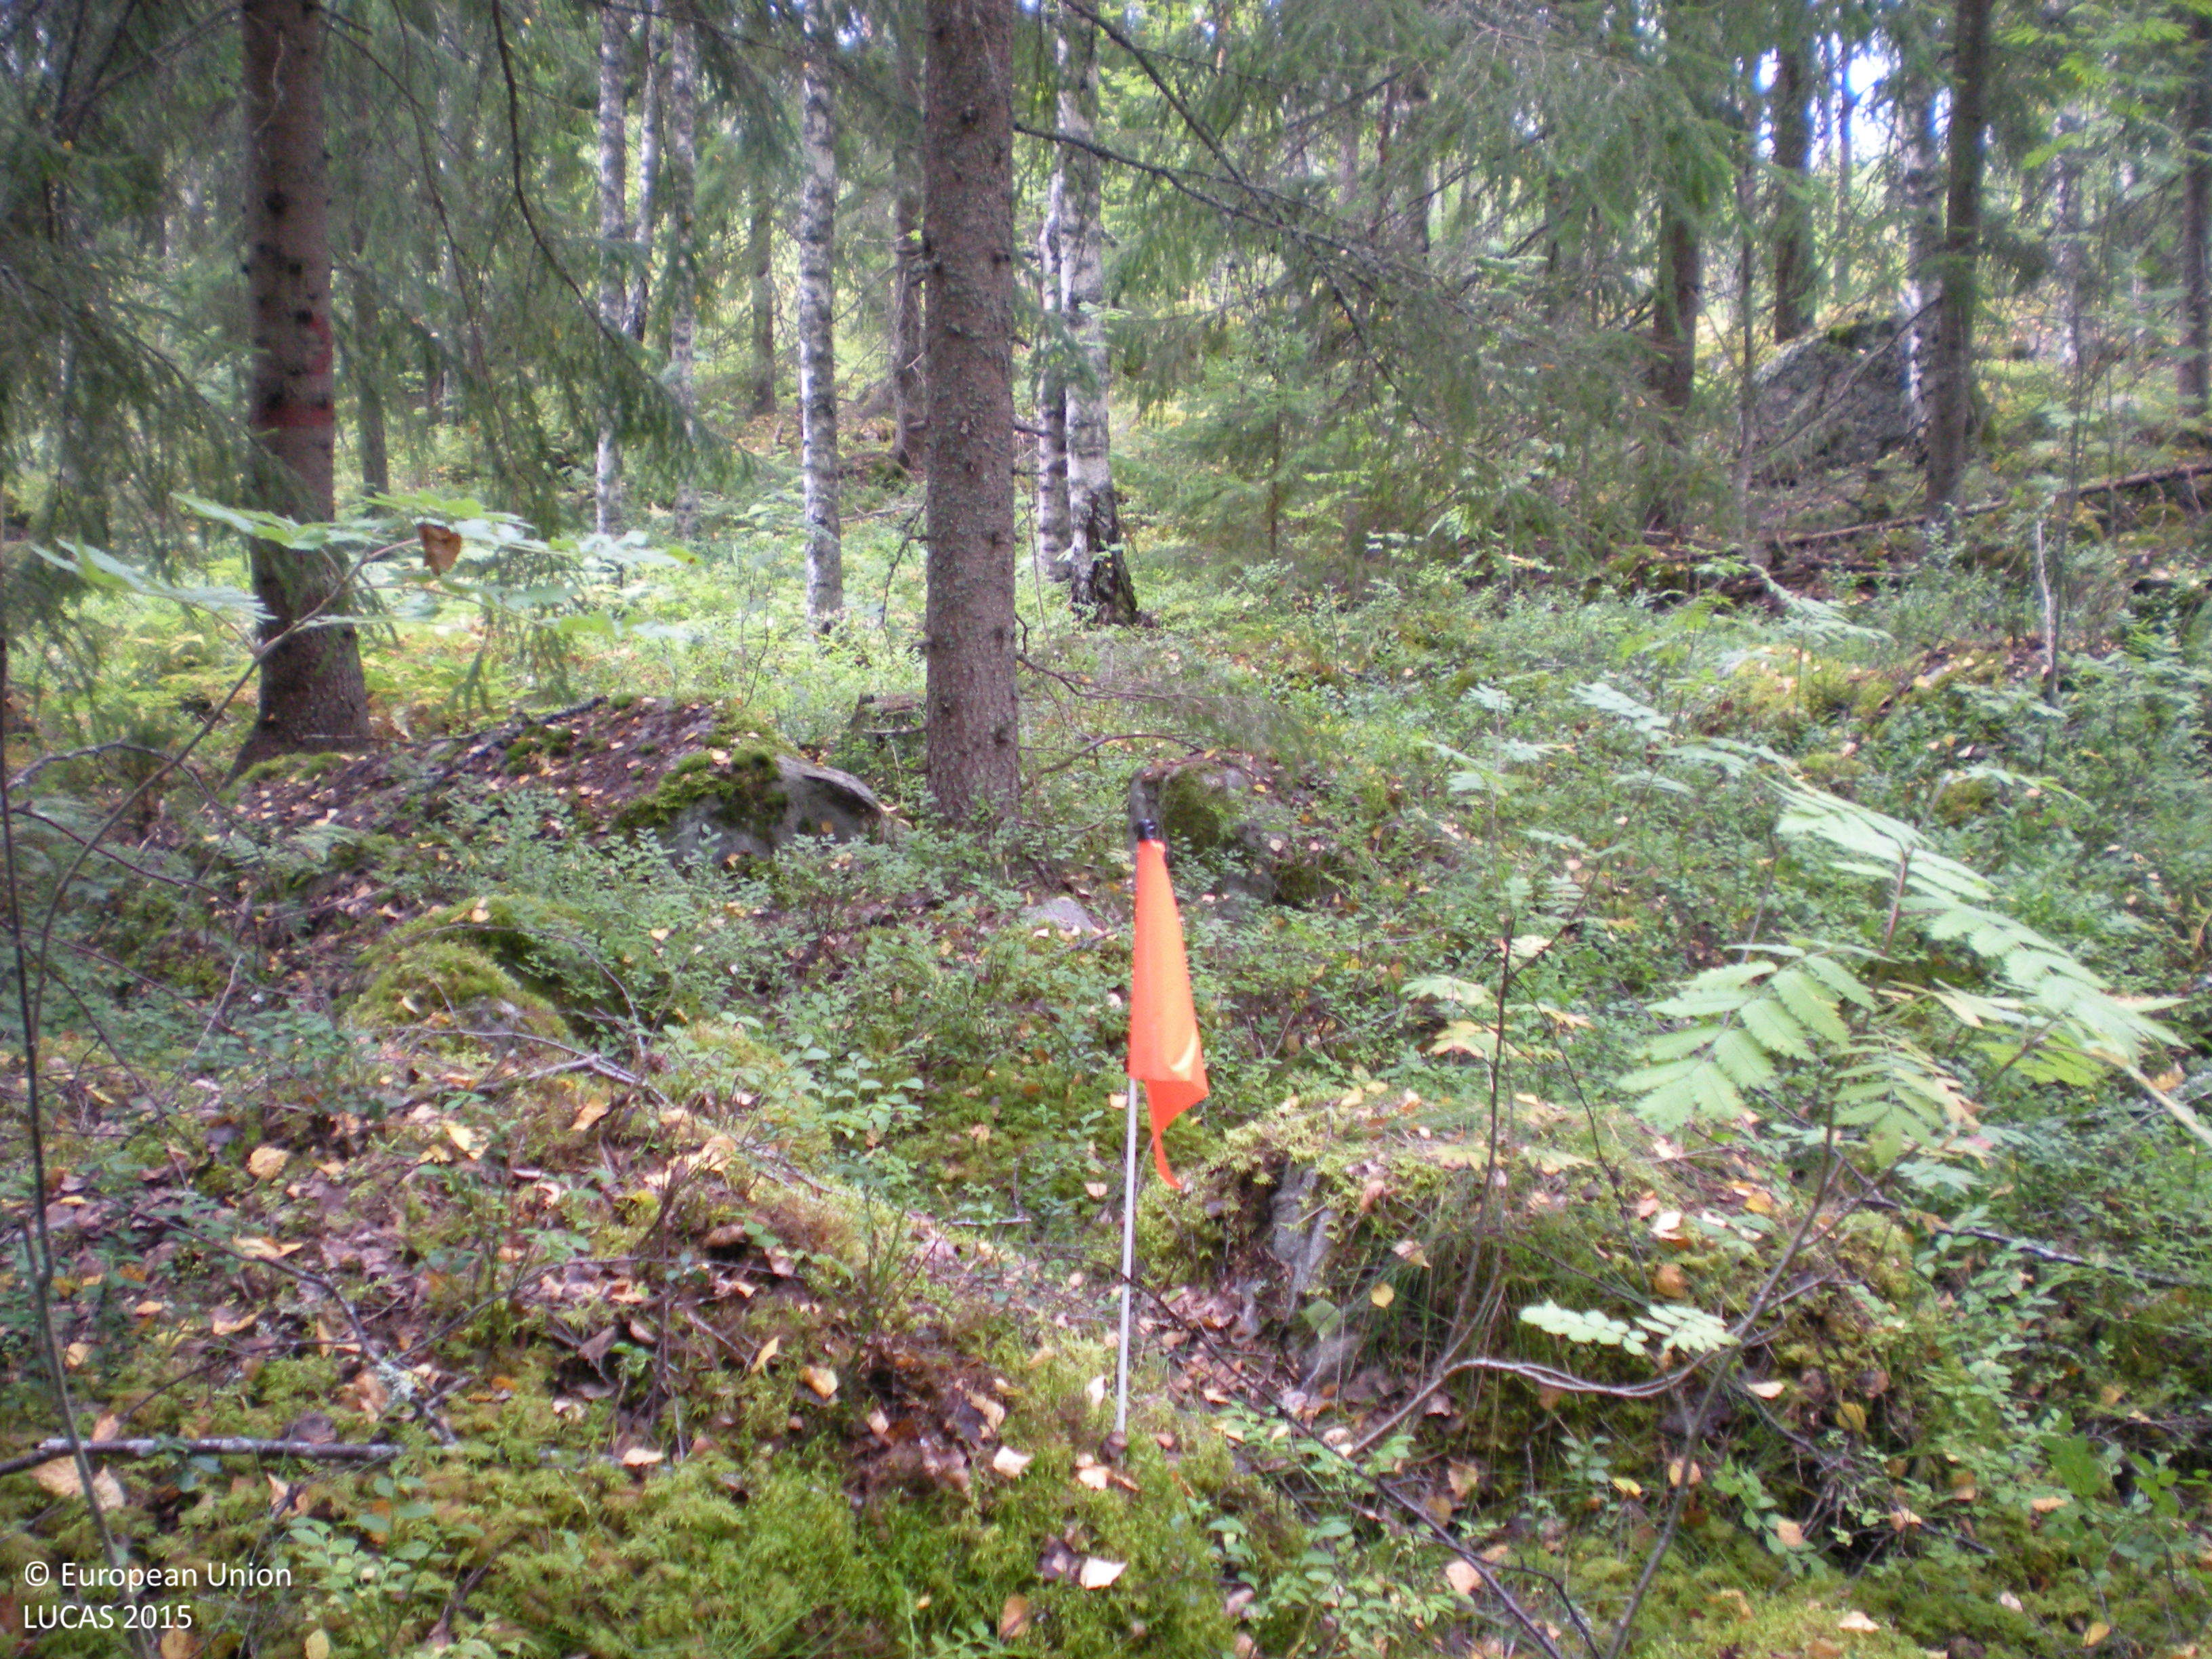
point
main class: Woodland
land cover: Spruce dominated coniferous woodland
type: boreal forest
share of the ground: 50 - 75 %
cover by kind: coniferous forest trees 55 %, shrubs 20 %, broadleaved forest trees 15 %, lichens and mosses 5 %, consolidated bare surface 5 %
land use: Forestry
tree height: > 5 m
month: August
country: SE
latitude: 60.5362
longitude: 17.2621
